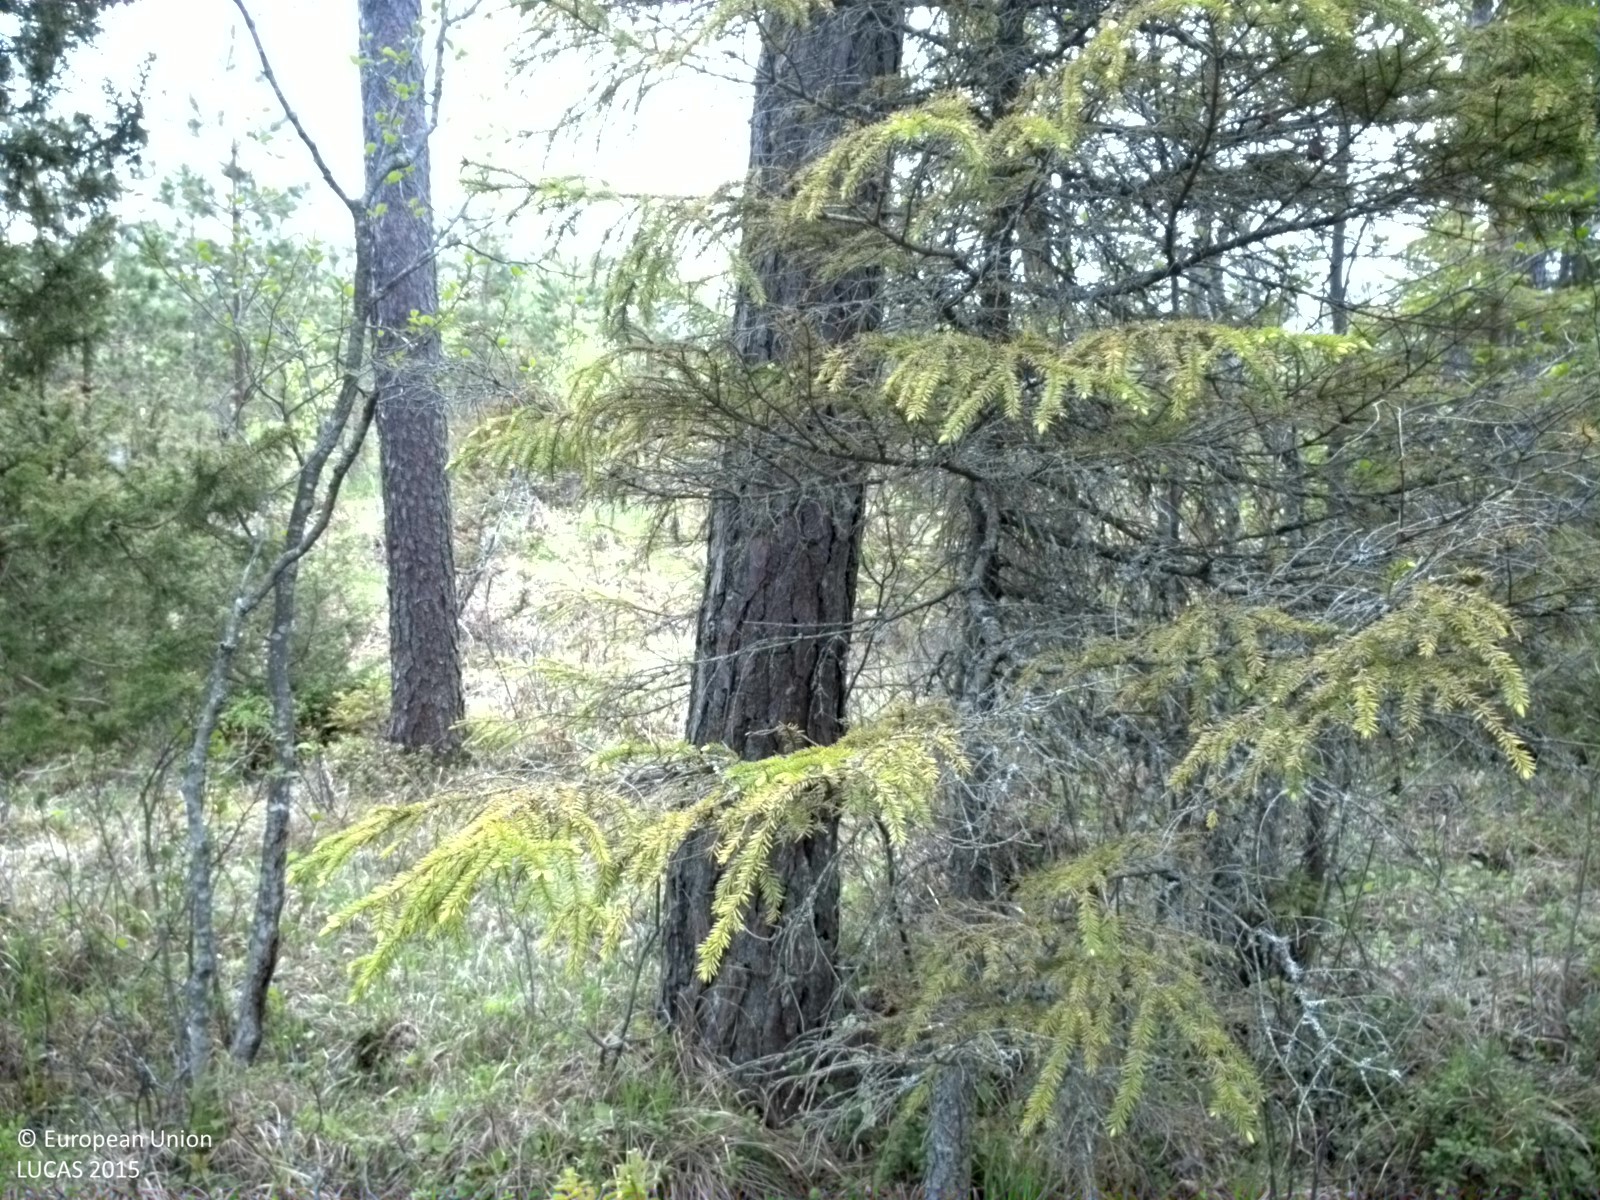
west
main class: Woodland
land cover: Spruce dominated mixed woodland
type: boreal forest
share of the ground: > 75 %
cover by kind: coniferous forest trees 40 %, broadleaved forest trees 40 %, herbaceous plants 15 %, shrubs 5 %
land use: Forestry
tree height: > 5 m
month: May
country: SE
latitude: 60.2928
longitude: 18.0804
